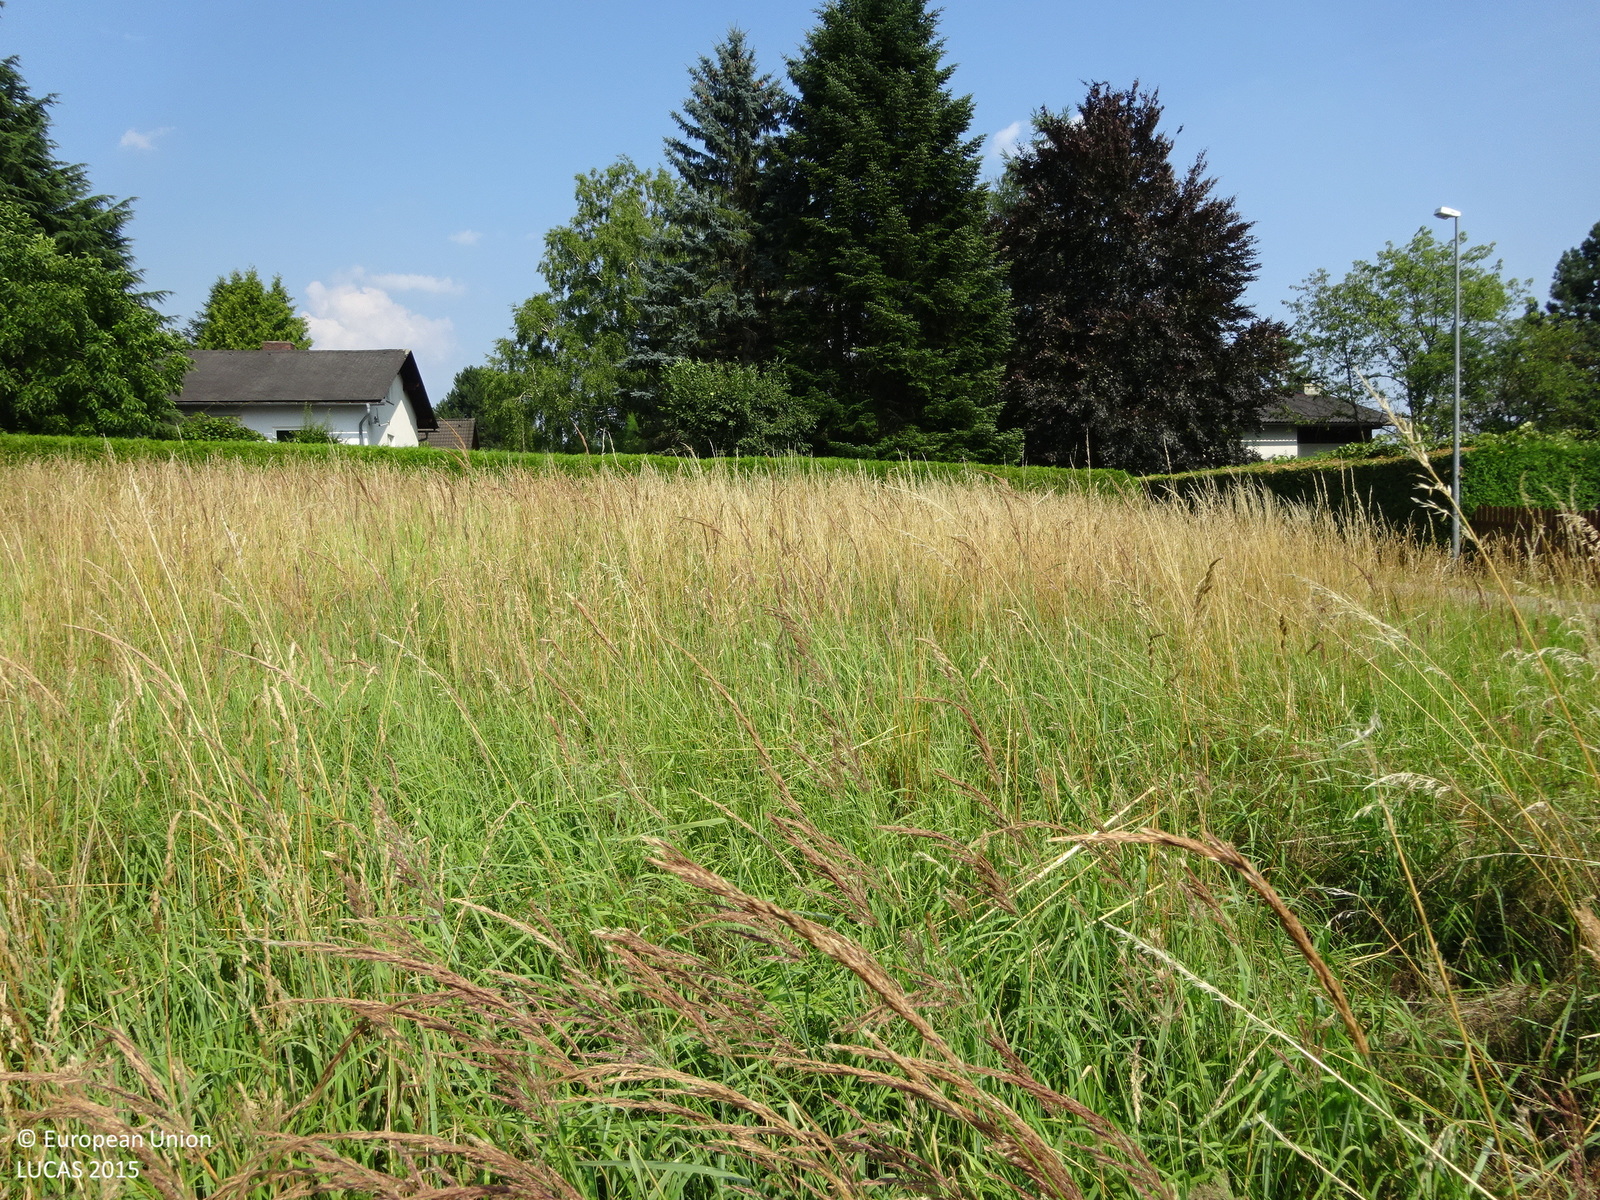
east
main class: Grassland
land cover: Grassland without tree/shrub cover
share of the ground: > 75 %
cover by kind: herbaceous plants 100 %
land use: Agriculture (excluding fallow land and kitchen gardens)
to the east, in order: Grassland without tree/shrub cover; Artificial constructions in urban areas; Grassland without tree/shrub cover; Grassland with sparse tree/shrub cover; Tracks; Grassland without tree/shrub cover
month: July
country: AT
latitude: 47.1382
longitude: 15.3398
